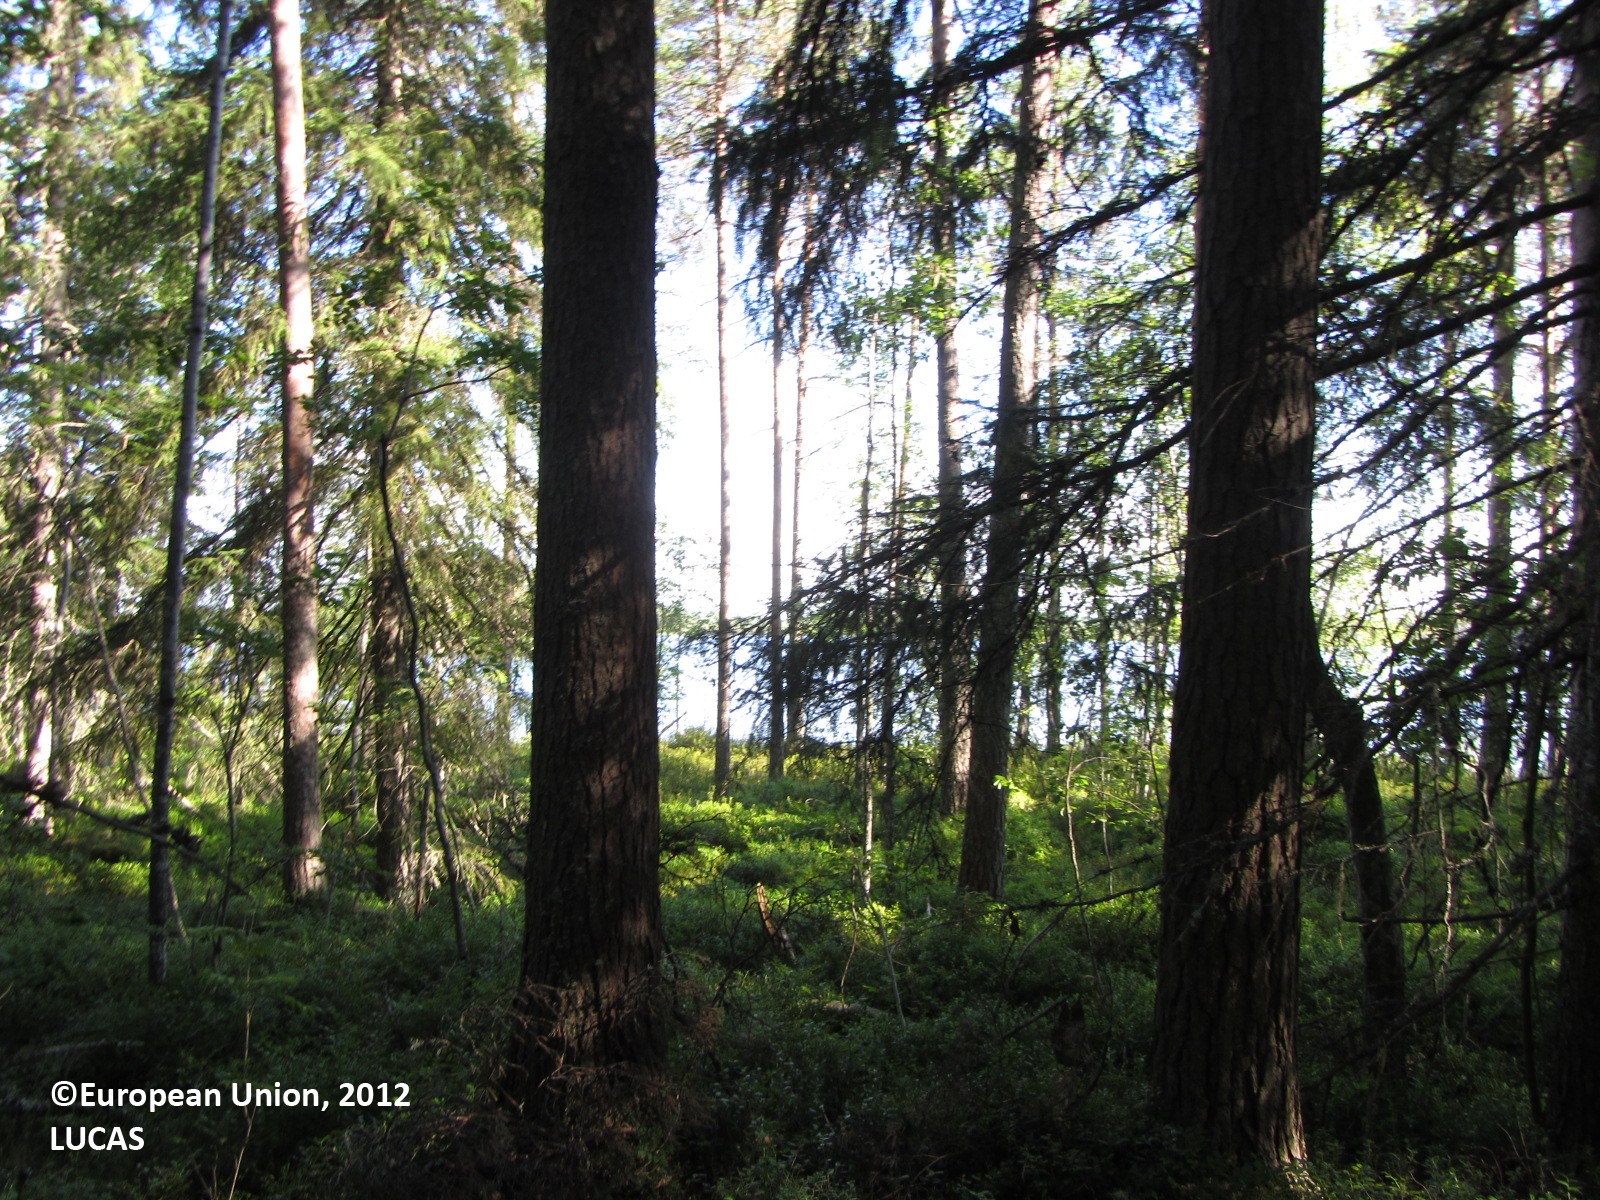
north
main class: Woodland
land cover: Other coniferous woodland
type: boreal forest
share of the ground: > 75 %
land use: Forestry
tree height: > 5 m
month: July
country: FI
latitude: 63.6722
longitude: 24.6935
